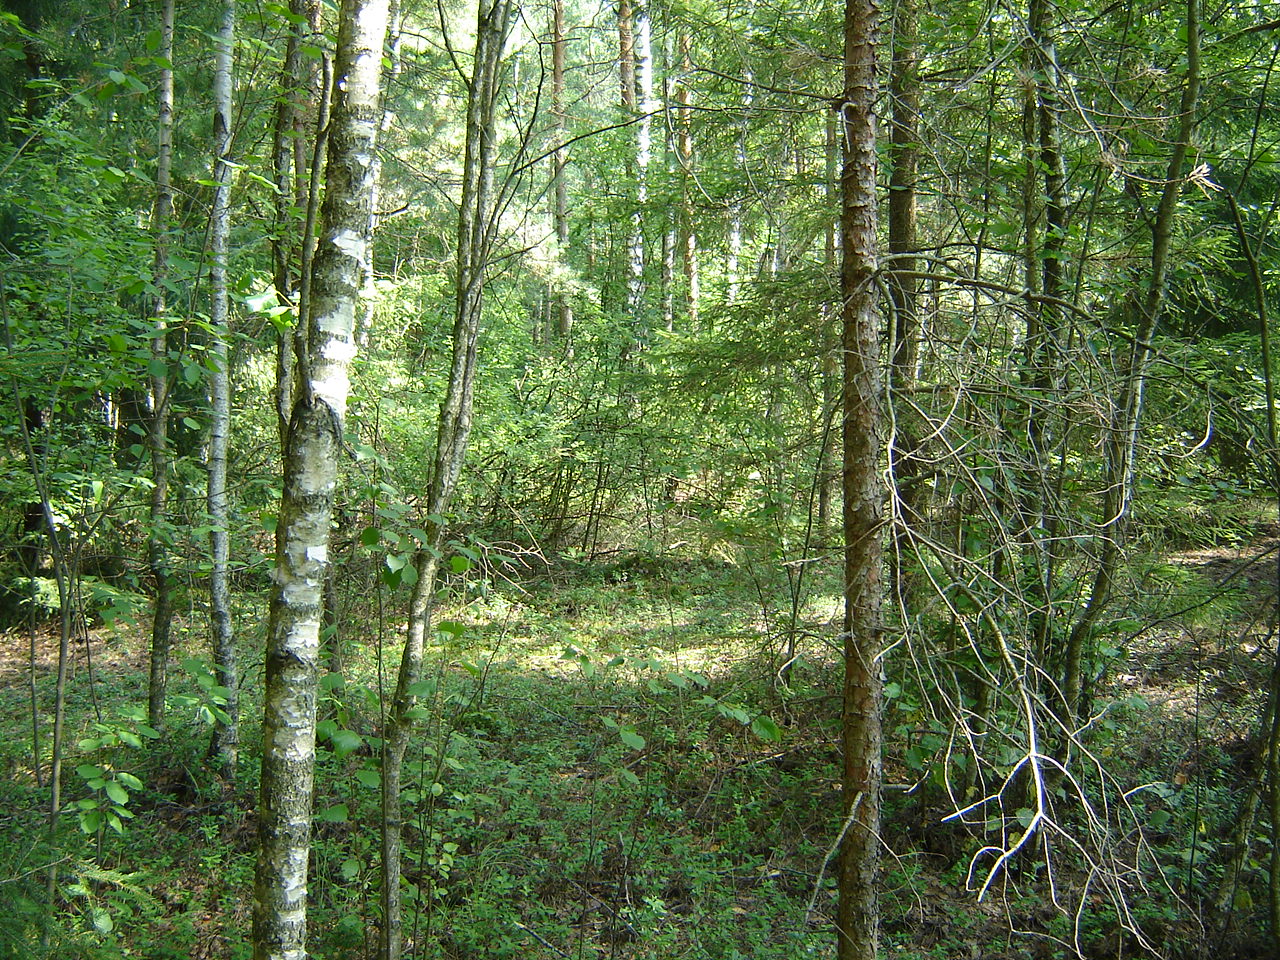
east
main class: Woodland
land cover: Other mixed woodland
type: hemiboreal forest and nemoral coniferous forest and mixed broadleaved-coniferous forest
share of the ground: > 75 %
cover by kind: broadleaved forest trees 50 %, coniferous forest trees 45 %, lichens and mosses 5 %
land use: Forestry
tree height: > 5 m
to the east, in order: Other mixed woodland; Spruce dominated mixed woodland; Other mixed woodland; Ditches and canals; Broadleaved woodland
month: August
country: LT
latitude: 55.0538
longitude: 24.9040
